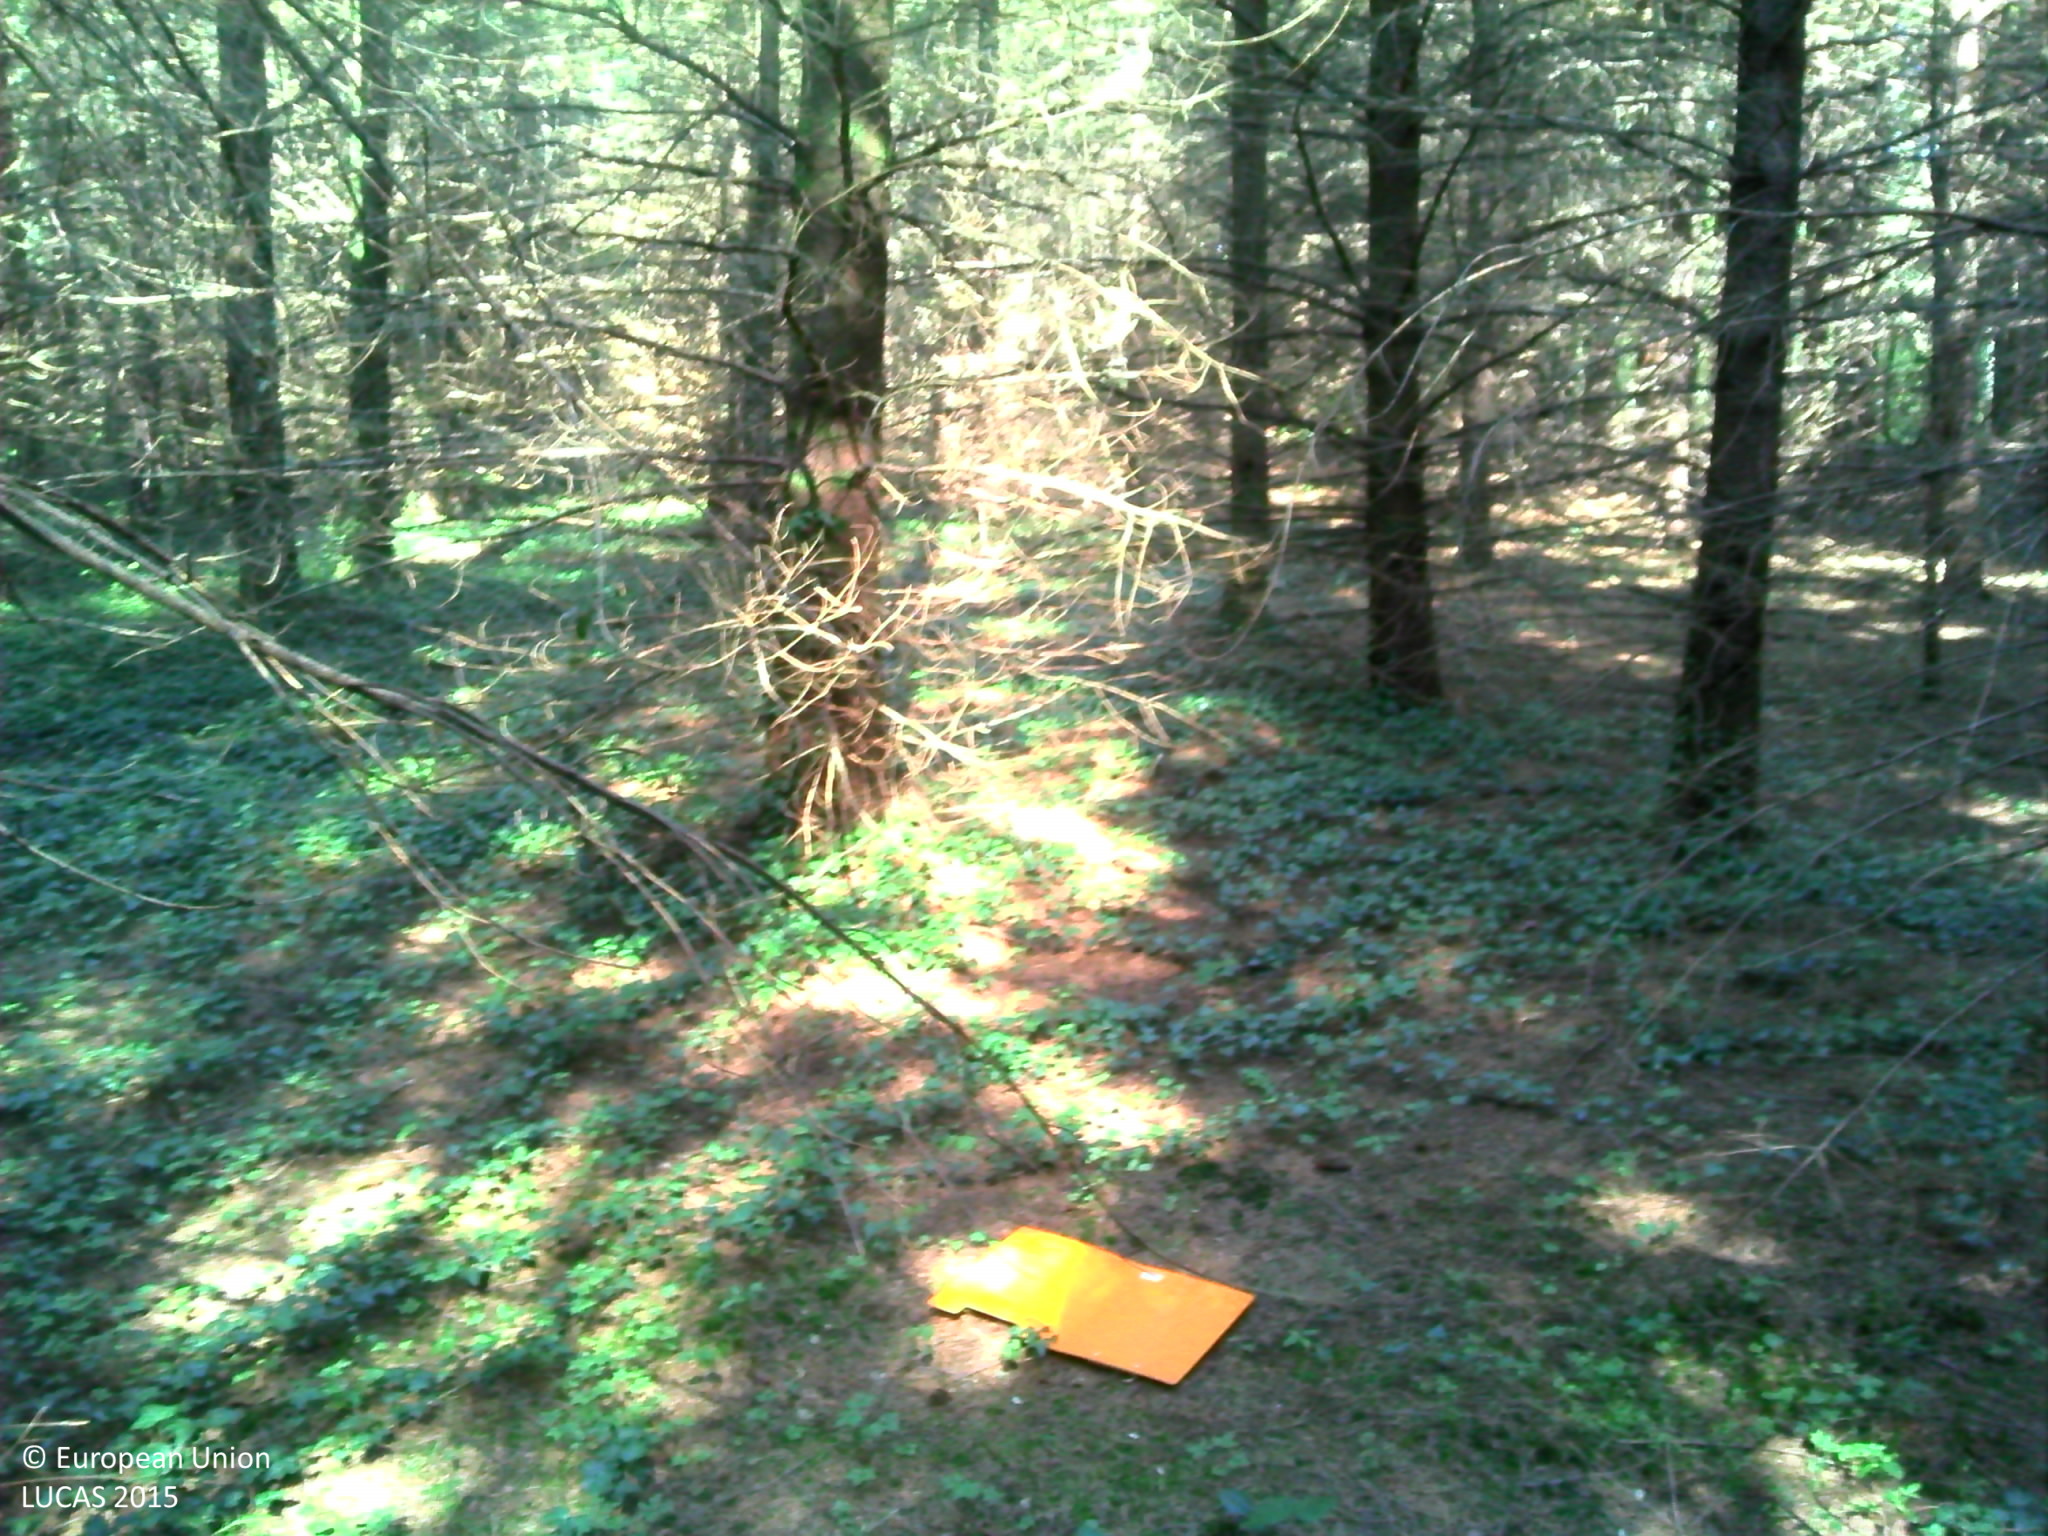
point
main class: Woodland
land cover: Spruce dominated coniferous woodland
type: hemiboreal forest and nemoral coniferous forest and mixed broadleaved-coniferous forest
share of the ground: > 75 %
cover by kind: coniferous forest trees 75 %, herbaceous plants 25 %
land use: Forestry
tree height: > 5 m
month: September
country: FR
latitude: 47.2054
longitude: 6.2658
